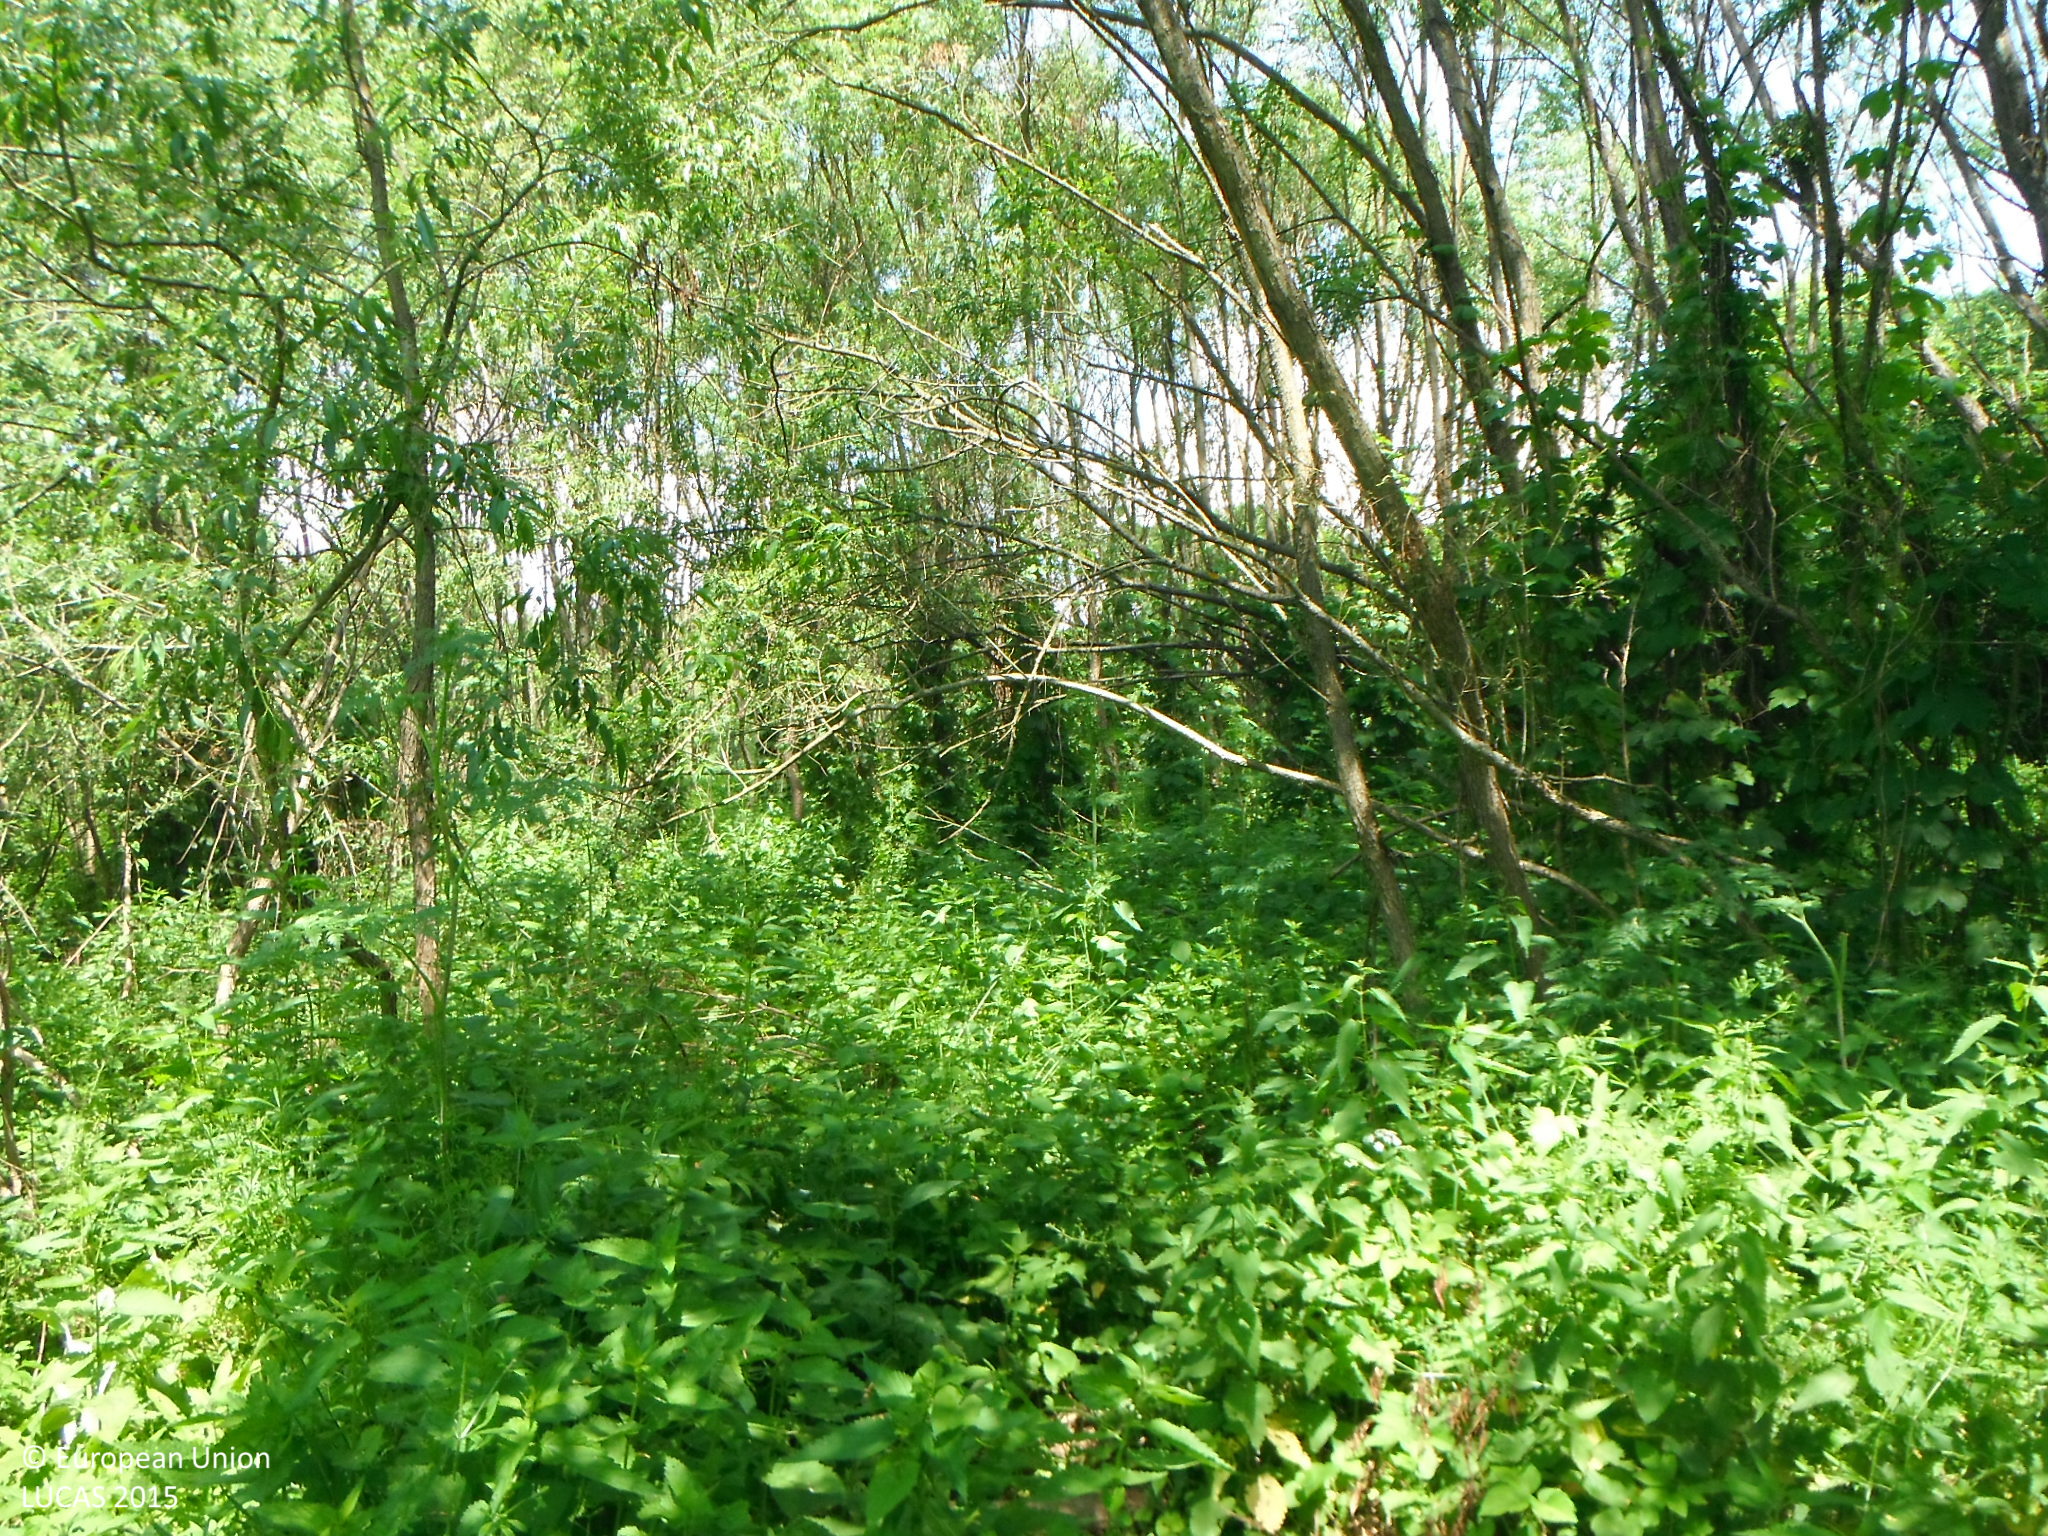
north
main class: Woodland
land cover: Broadleaved woodland
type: mire and swamp forests
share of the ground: > 75 %
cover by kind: broadleaved forest trees 85 %, shrubs 10 %, herbaceous plants 5 %
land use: Semi-natural and natural areas not in use
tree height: > 5 m
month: June
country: SK
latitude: 48.6876
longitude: 19.2191
